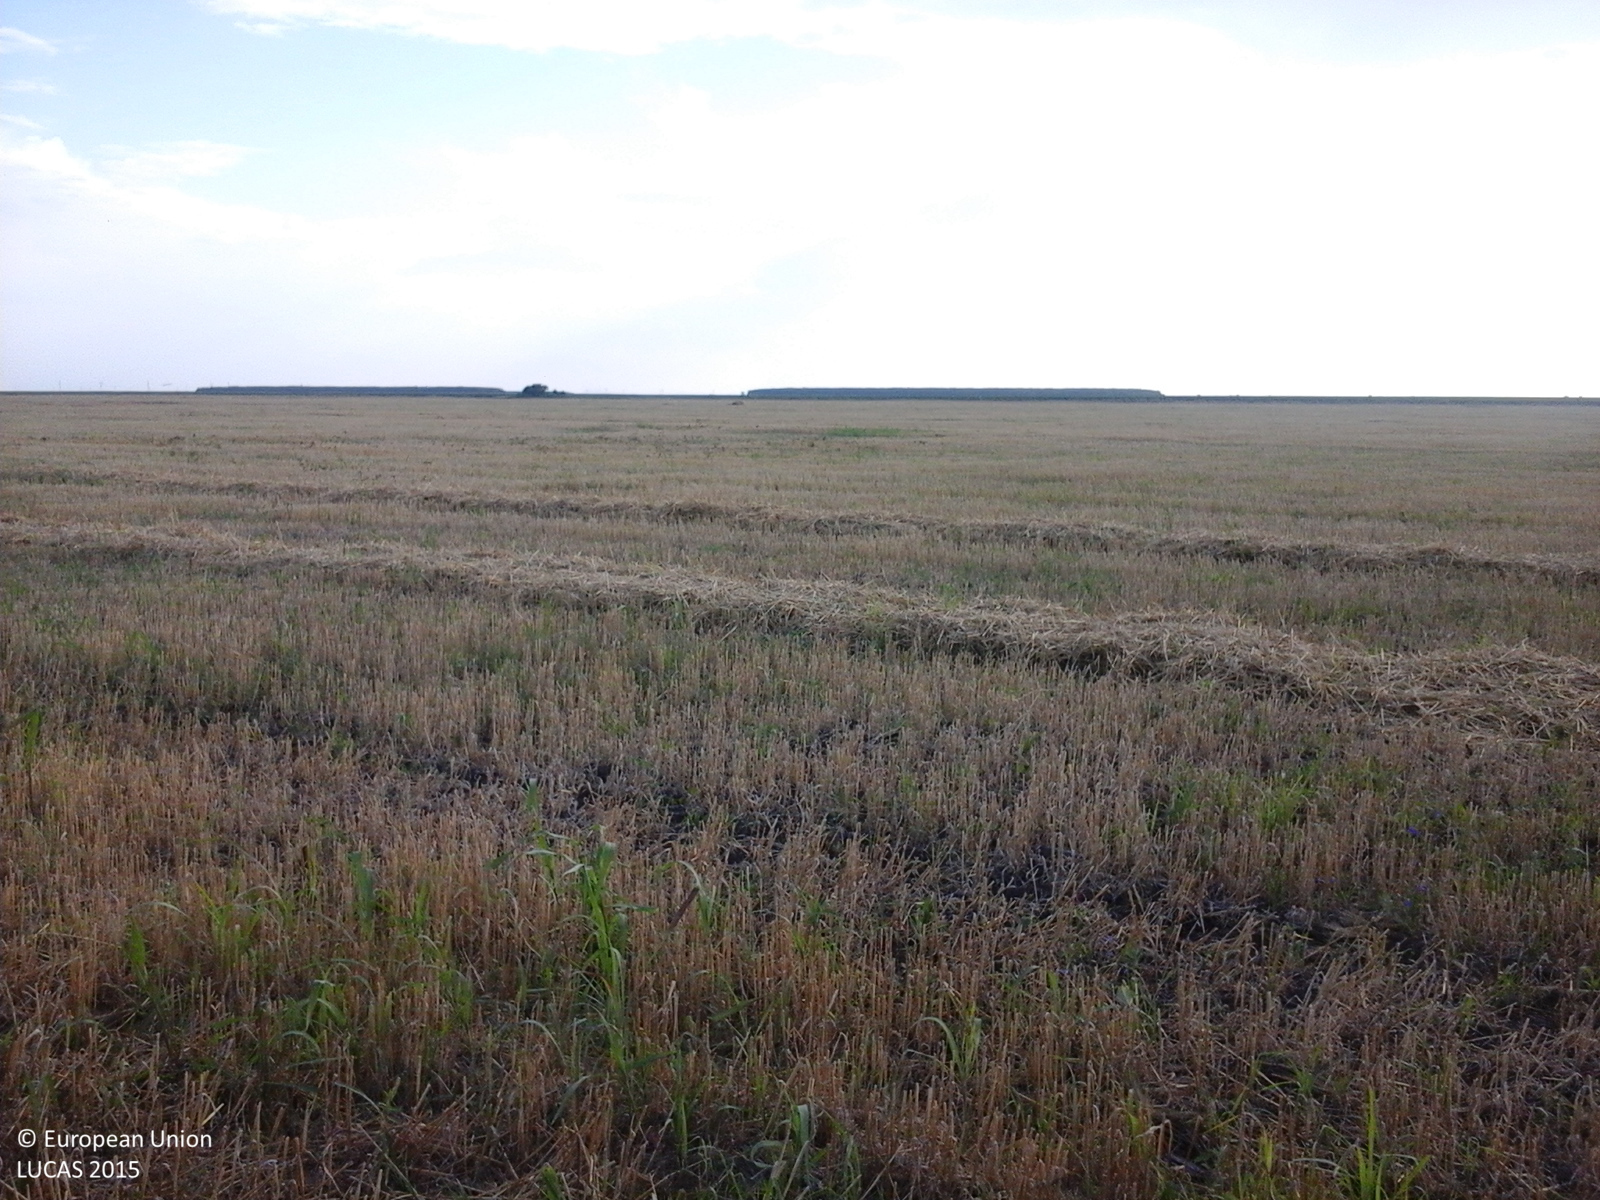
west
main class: Cropland
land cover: Rye
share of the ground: < 10 %
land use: Agriculture (excluding fallow land and kitchen gardens)
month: July
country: RO
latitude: 43.9669
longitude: 25.7339
